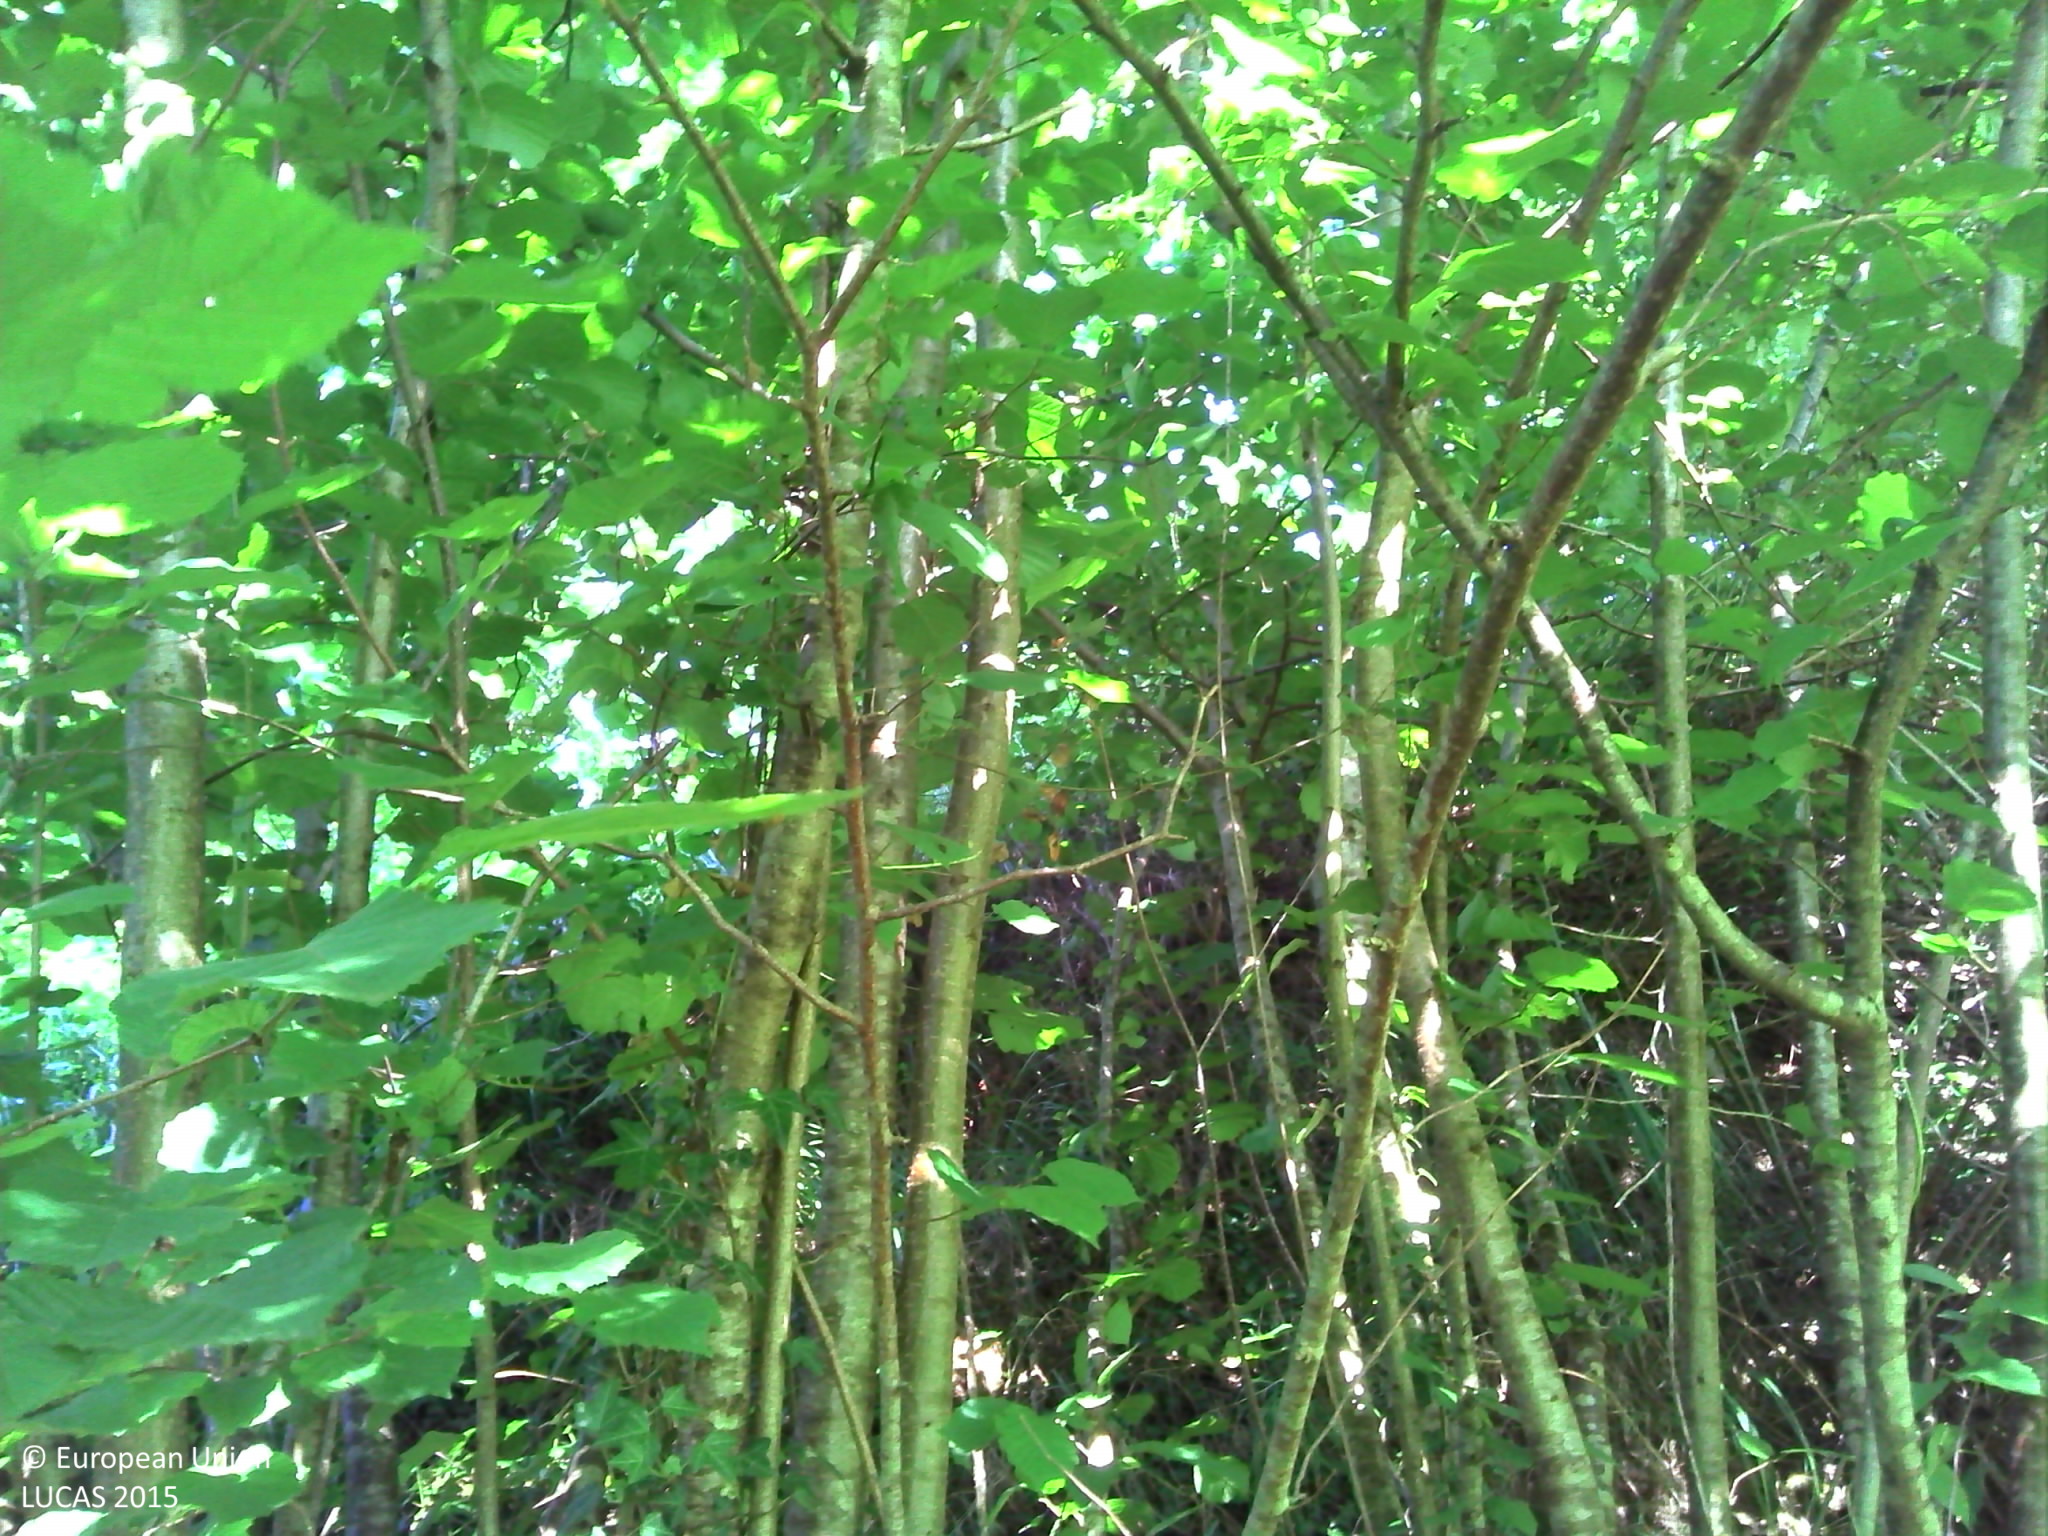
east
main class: Woodland
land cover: Broadleaved woodland
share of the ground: > 75 %
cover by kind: broadleaved forest trees 55 %, herbaceous plants 35 %, shrubs 10 %
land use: Agriculture (excluding fallow land and kitchen gardens)
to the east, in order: Broadleaved woodland; Grassland without tree/shrub cover; Shruby margins; Grassland without tree/shrub cover; Shrubland with sparse tree cover; Fences; Grassland without tree/shrub cover; Artificial constructions in urban areas; Grassland with sparse tree/shrub cover; Conifer hedges; Grassland without tree/shrub cover; Fences; Grassland with sparse tree/shrub cover; Spruce dominated mixed woodland; Managed hedges; Grass margins; Electric lines; Paved roads, cycling and walking lanes; Ditches and canals; Grass margins; Spruce dominated mixed woodland
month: July
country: FR
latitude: 42.9885
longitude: -0.4174
